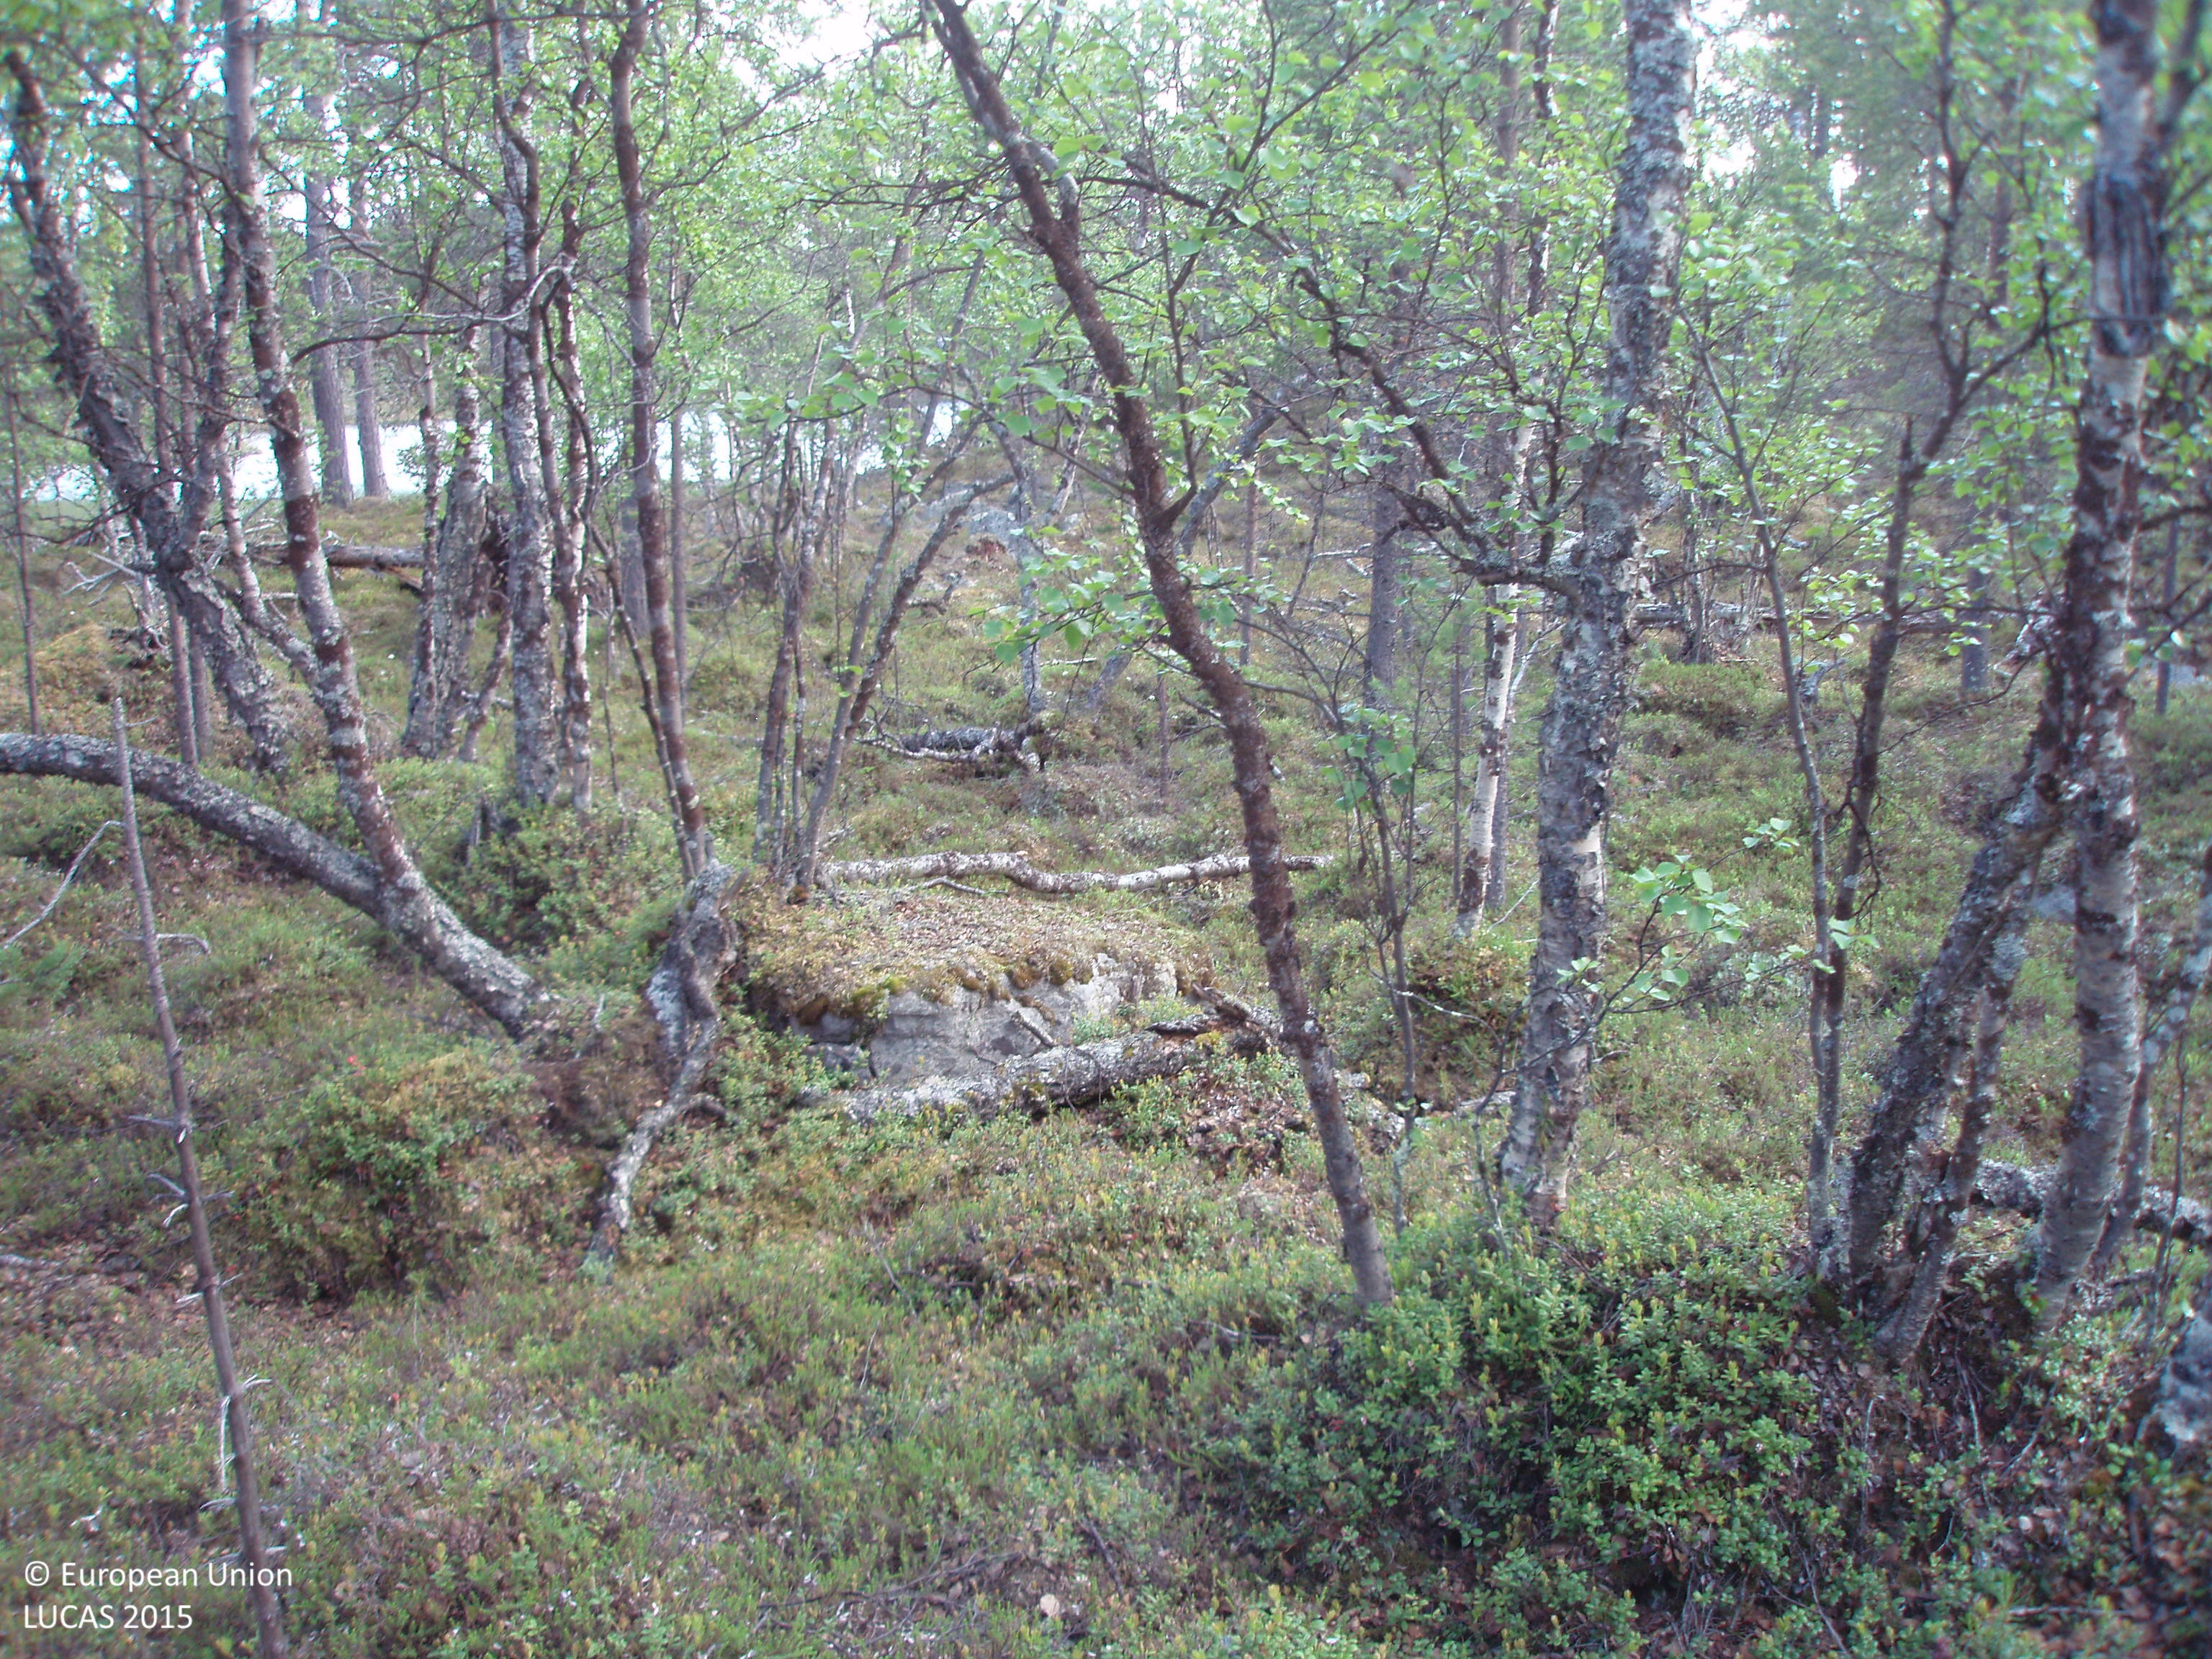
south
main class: Woodland
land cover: Pine dominated mixed woodland
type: boreal forest
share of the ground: > 75 %
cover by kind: broadleaved forest trees 45 %, coniferous forest trees 35 %, shrubs 20 %
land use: Forestry
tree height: > 5 m
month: July
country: FI
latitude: 69.5867
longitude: 28.7734
